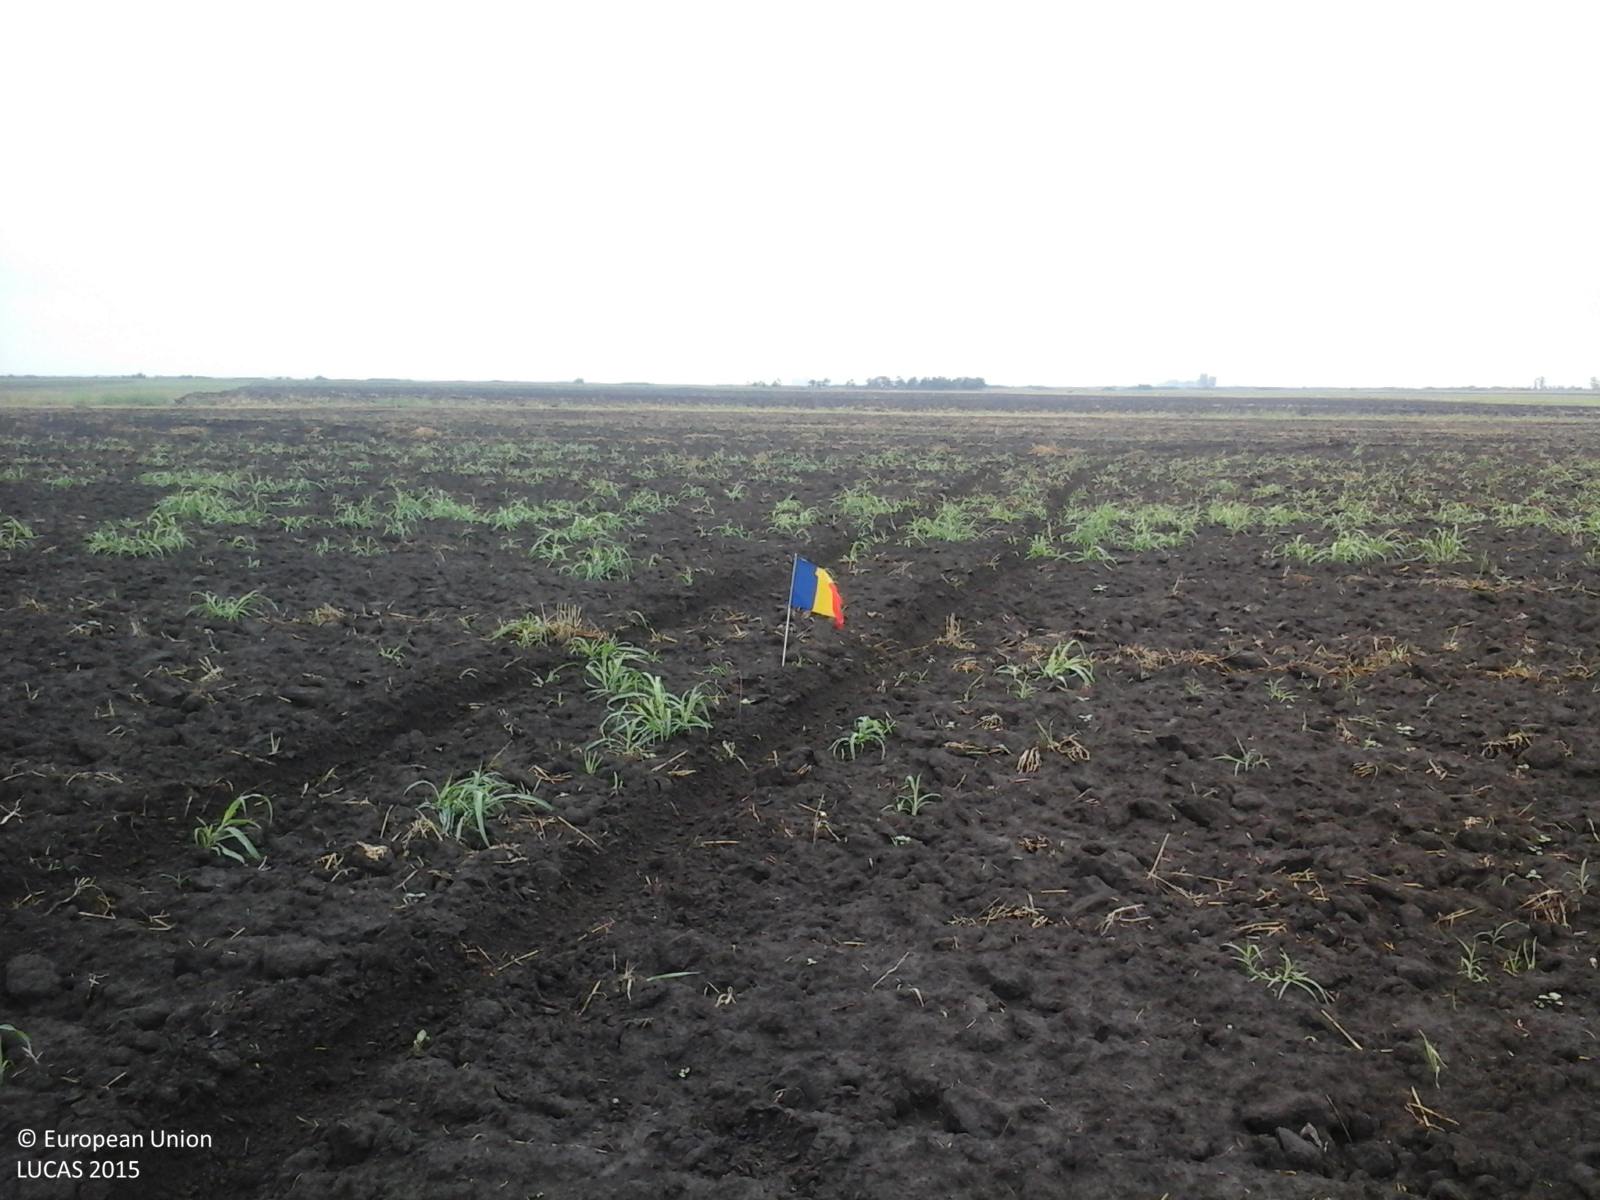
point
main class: Cropland
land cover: Common wheat
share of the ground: < 10 %
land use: Agriculture (excluding fallow land and kitchen gardens)
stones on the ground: < 10 %
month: August
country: RO
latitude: 46.0172
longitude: 20.4733
